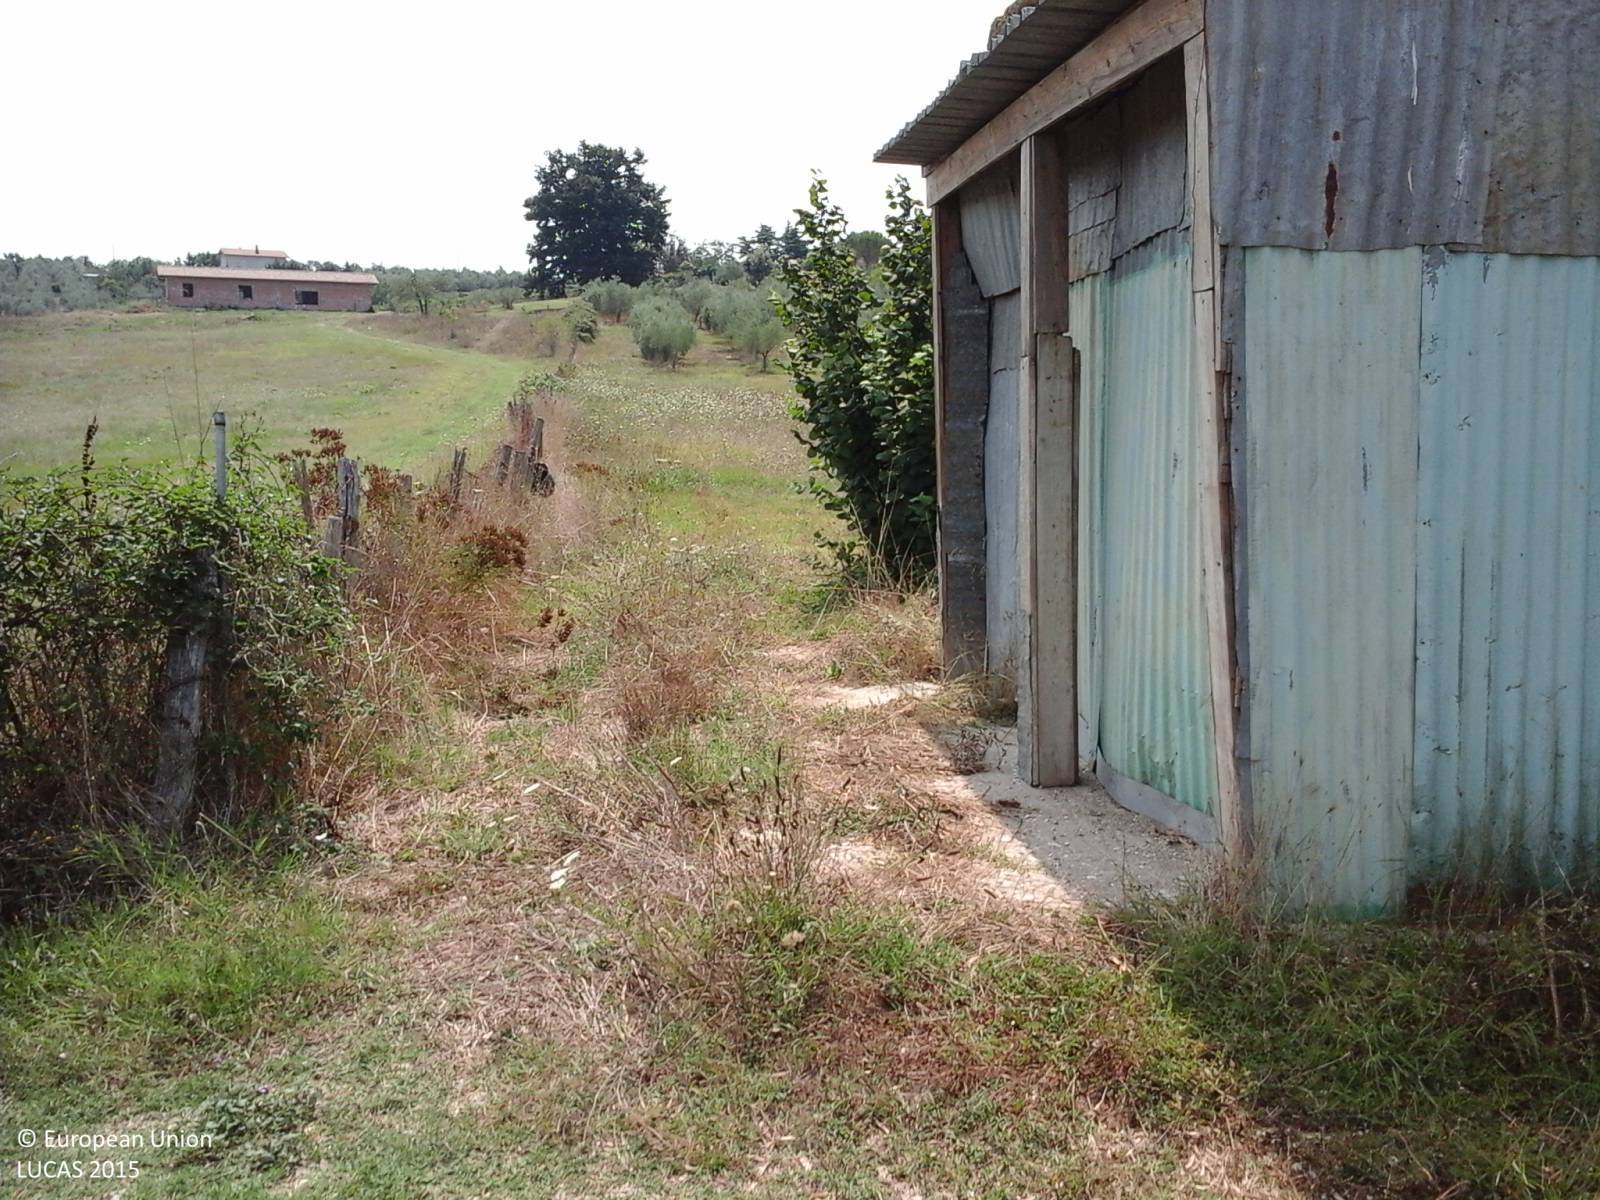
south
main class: Cropland
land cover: Nuts trees
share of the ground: > 75 %
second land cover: Other bare soil
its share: > 75 %
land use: Agriculture (excluding fallow land and kitchen gardens)
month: August
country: IT
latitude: 42.2334
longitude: 12.1613
